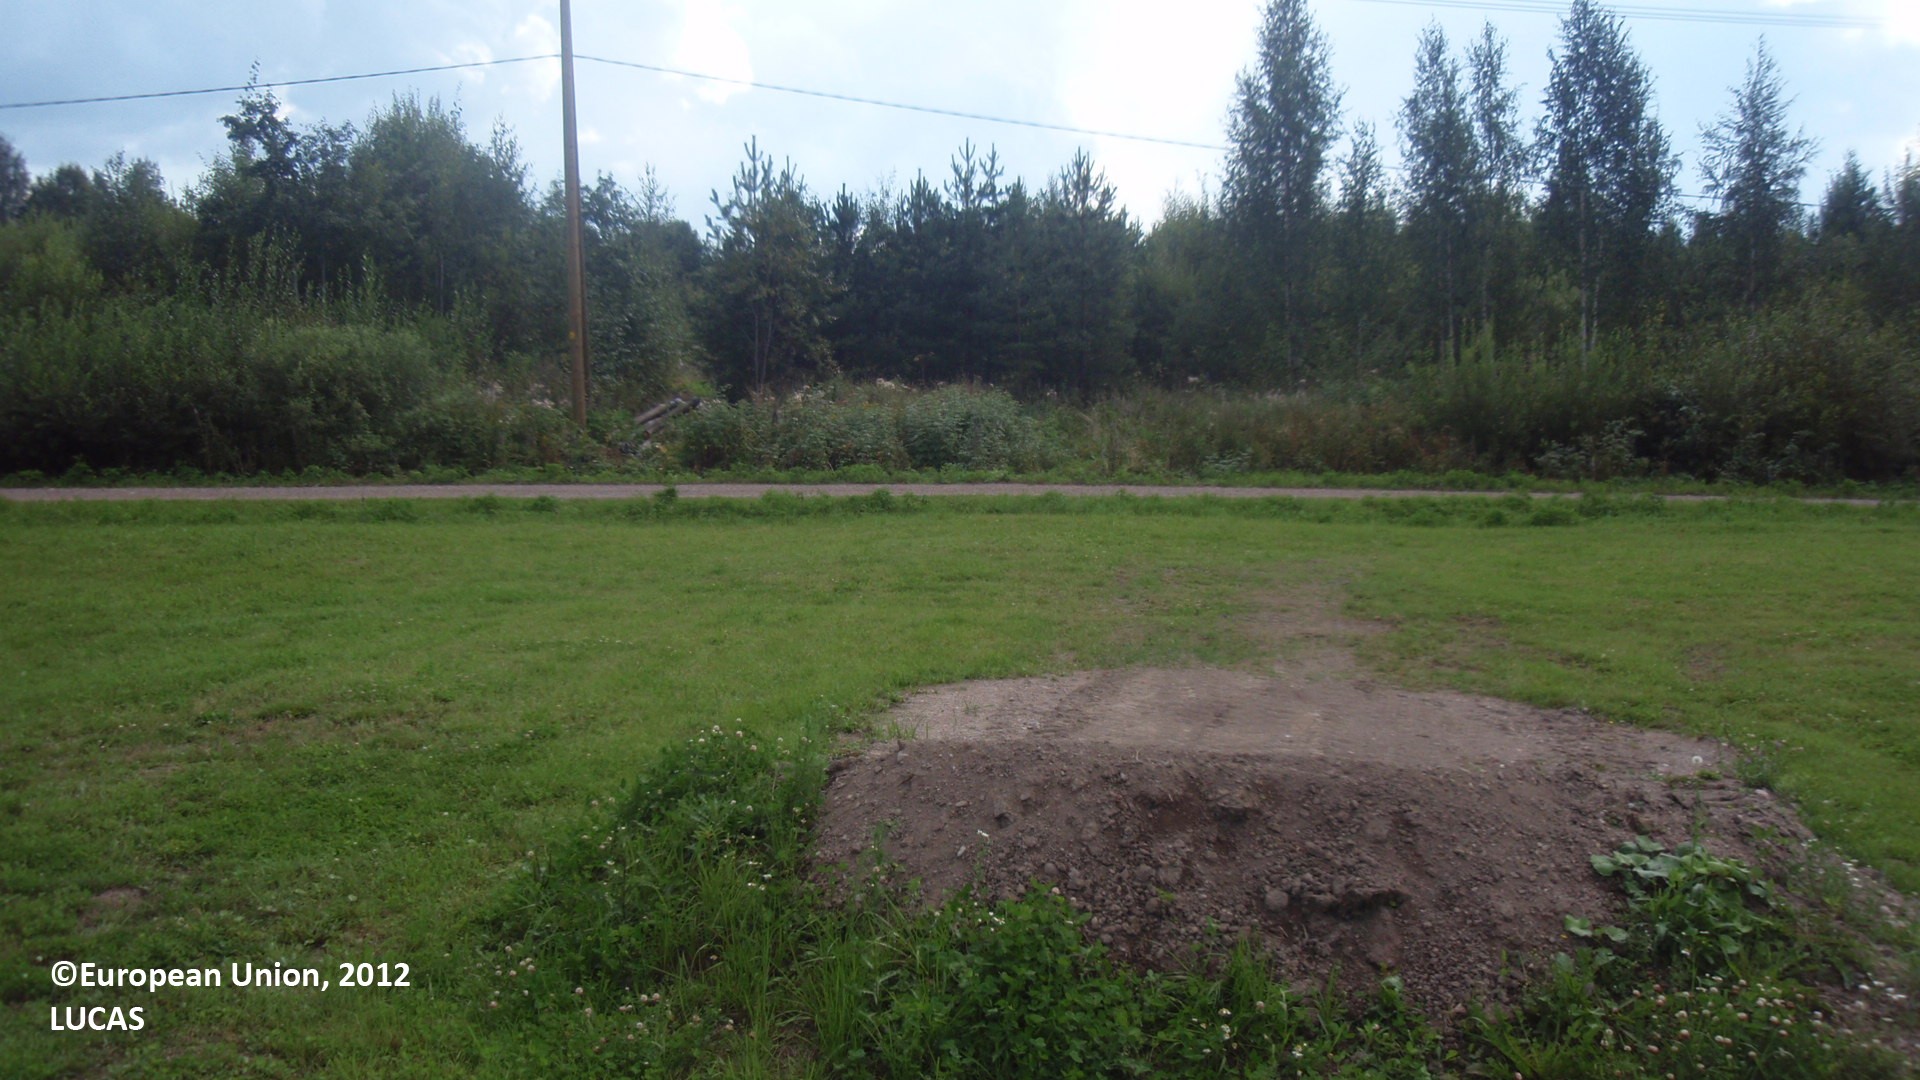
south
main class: Grassland
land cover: Grassland without tree/shrub cover
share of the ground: > 75 %
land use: Residential
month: August
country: FI
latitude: 60.9323
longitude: 26.6716
